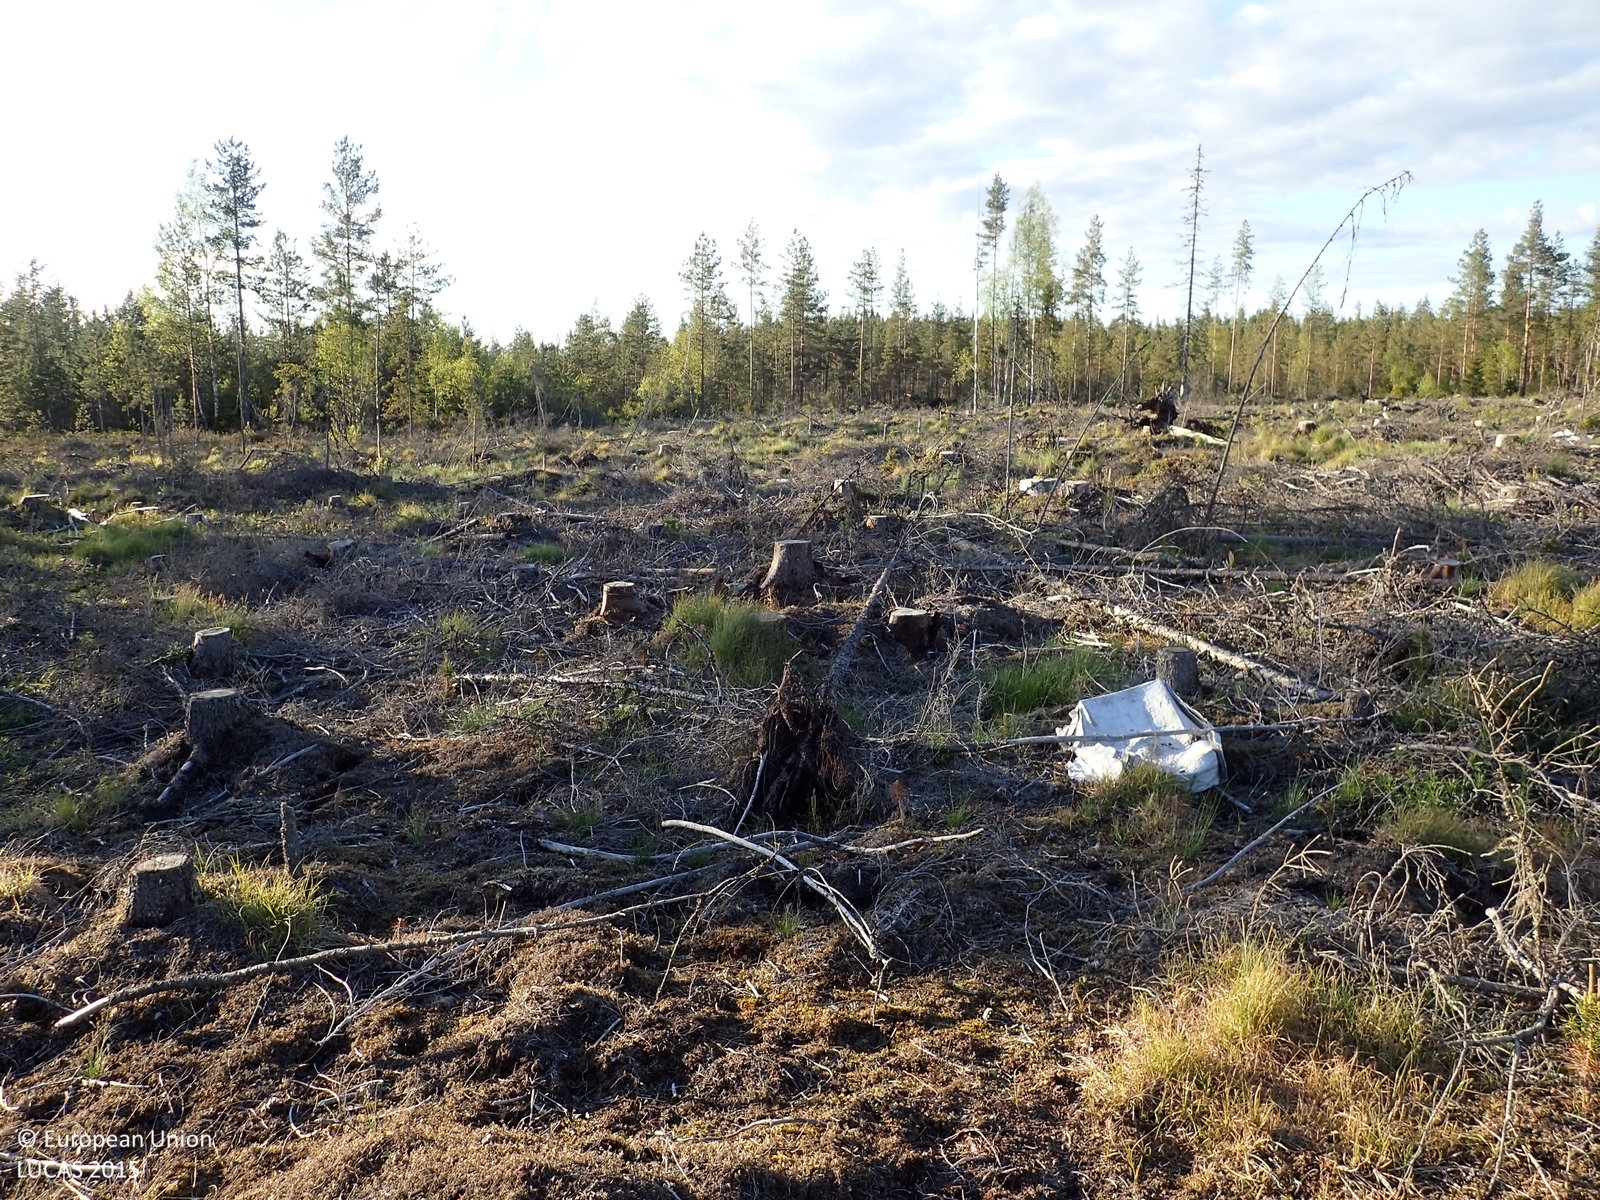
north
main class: Grassland
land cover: Grassland with sparse tree/shrub cover
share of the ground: 25 - 50 %
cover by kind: lichens and mosses 55 %, herbaceous plants 25 %, coniferous forest trees 5 %, shrubs 5 %, unconsolidated bare surface 5 %
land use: Forestry
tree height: < 5 m
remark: Clear cut
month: June
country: FI
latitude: 62.1990
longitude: 21.8308
